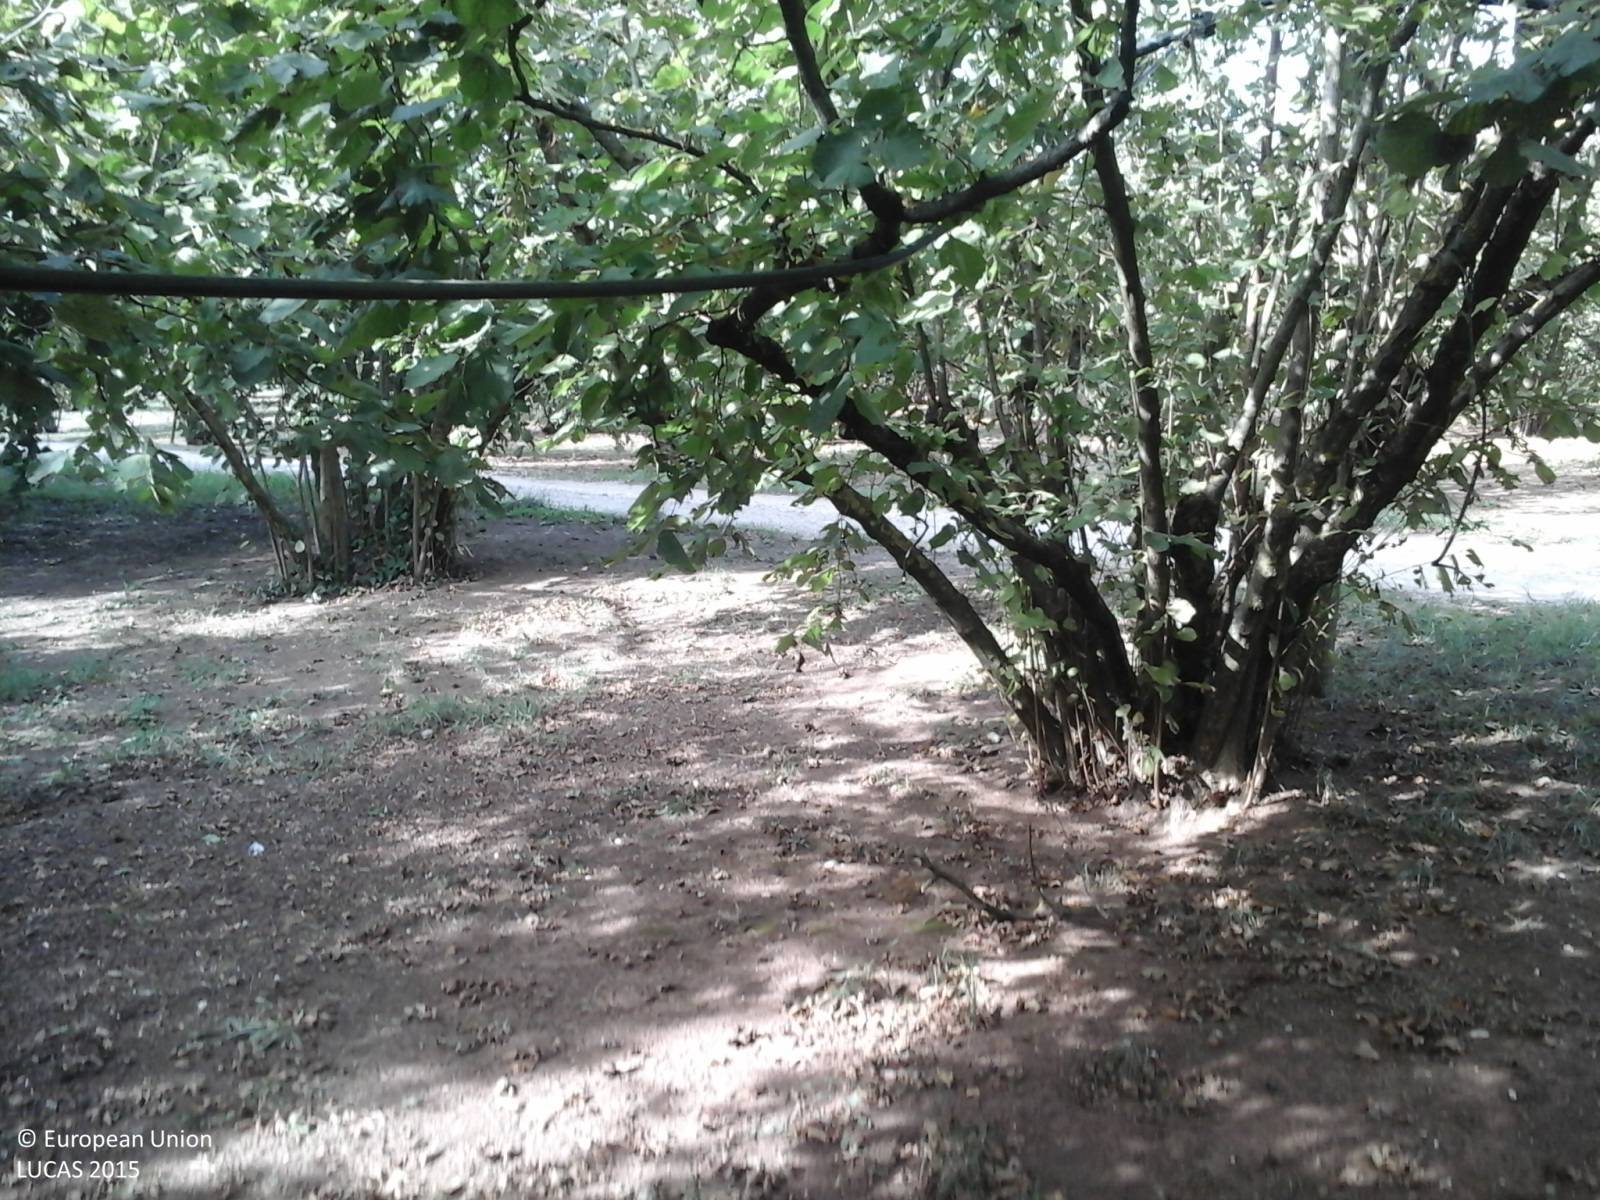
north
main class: Cropland
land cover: Nuts trees
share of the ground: > 75 %
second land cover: Other bare soil
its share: > 75 %
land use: Agriculture (excluding fallow land and kitchen gardens)
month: September
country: IT
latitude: 42.3741
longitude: 12.3359
